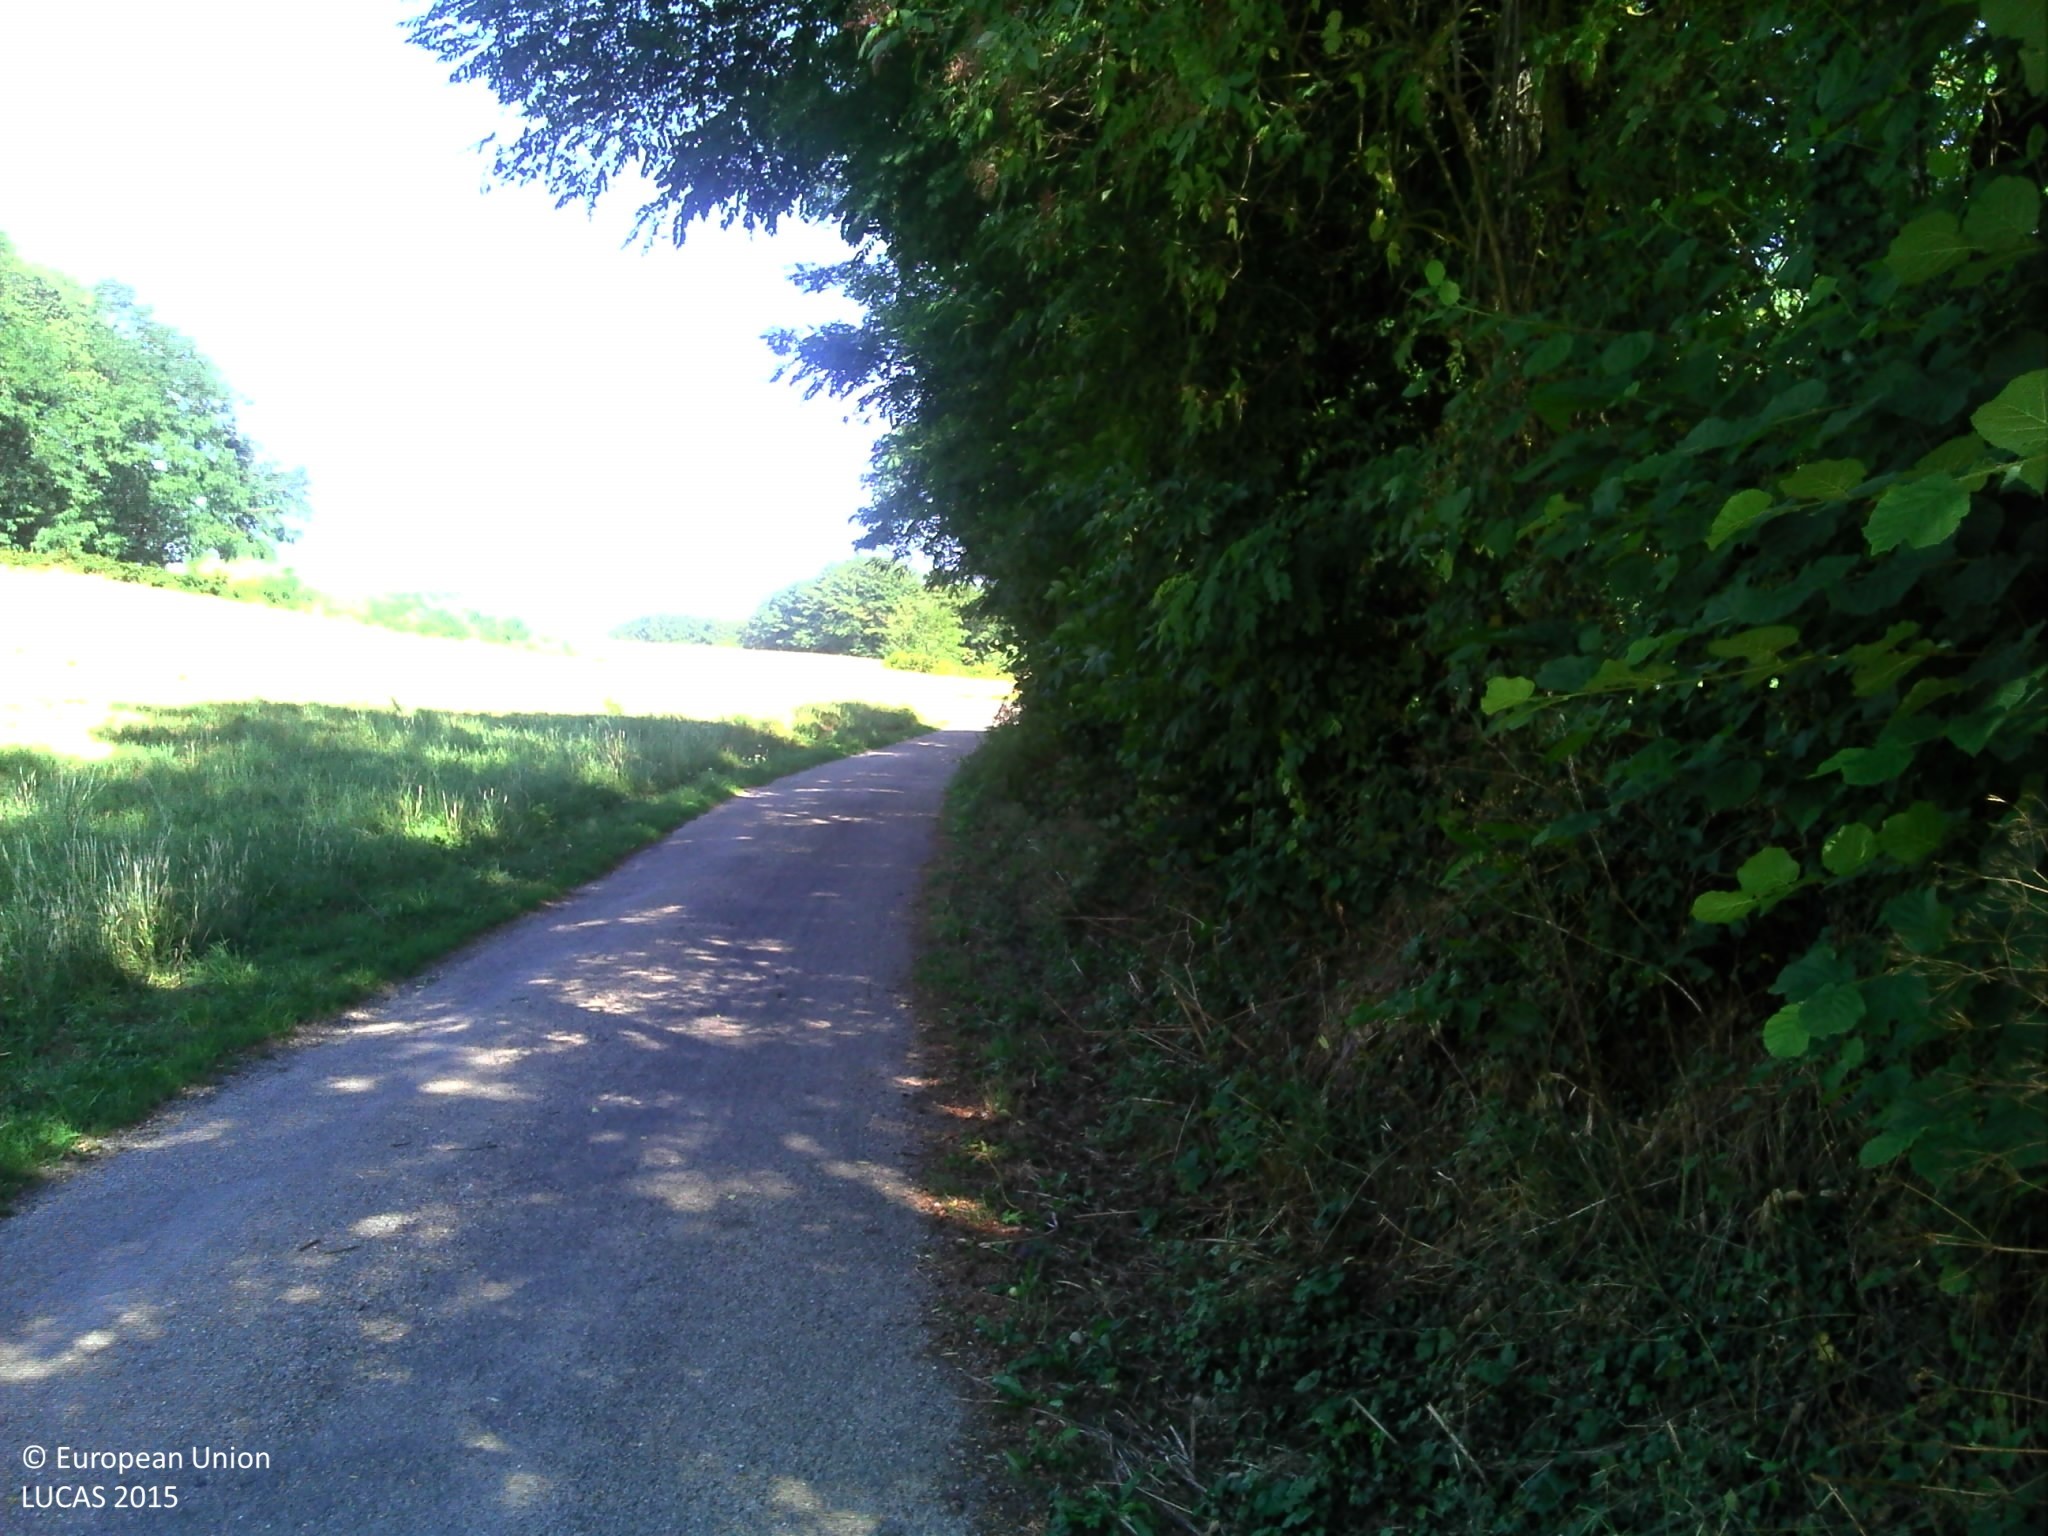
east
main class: Grassland
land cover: Grassland without tree/shrub cover
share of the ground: > 75 %
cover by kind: herbaceous plants 100 %
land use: Agriculture (excluding fallow land and kitchen gardens)
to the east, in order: Grassland without tree/shrub cover; Lines of trees; Fences; Broadleaved woodland; Paved roads, cycling and walking lanes; Grassland without tree/shrub cover; Electric lines; Grassland without tree/shrub cover; Maize
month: July
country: FR
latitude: 45.6050
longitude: 5.4528
